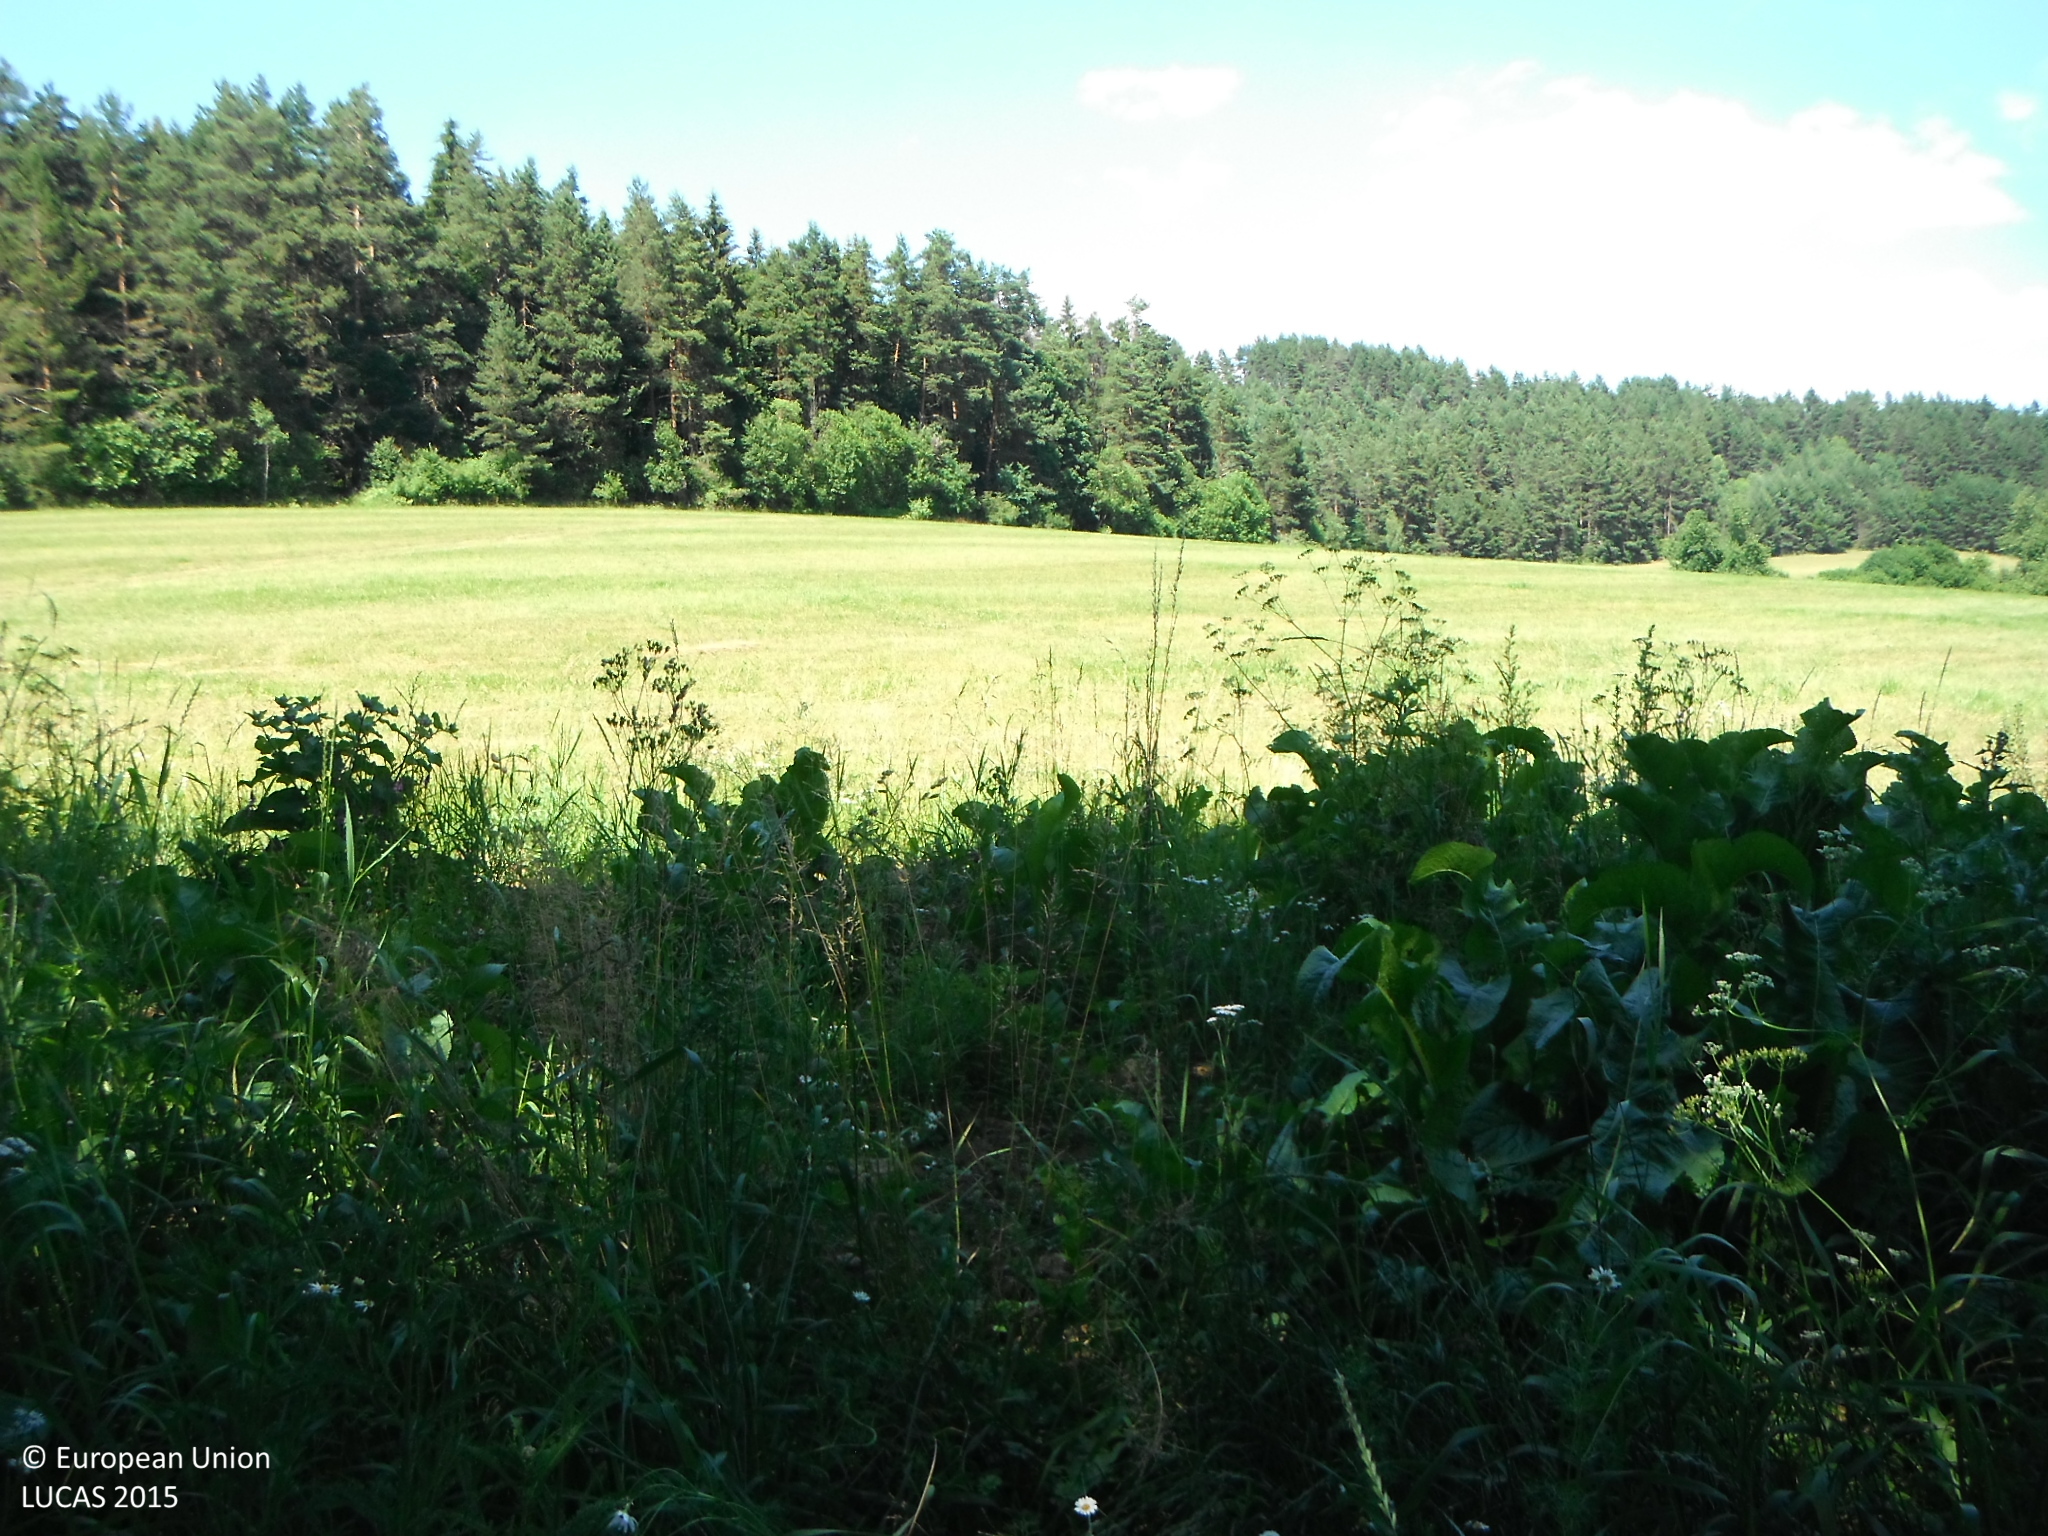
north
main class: Woodland
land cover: Broadleaved woodland
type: mesophytic deciduous forest
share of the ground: 50 - 75 %
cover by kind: broadleaved forest trees 60 %, herbaceous plants 40 %
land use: Forestry
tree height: > 5 m
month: July
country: SK
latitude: 48.9201
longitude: 20.6688
